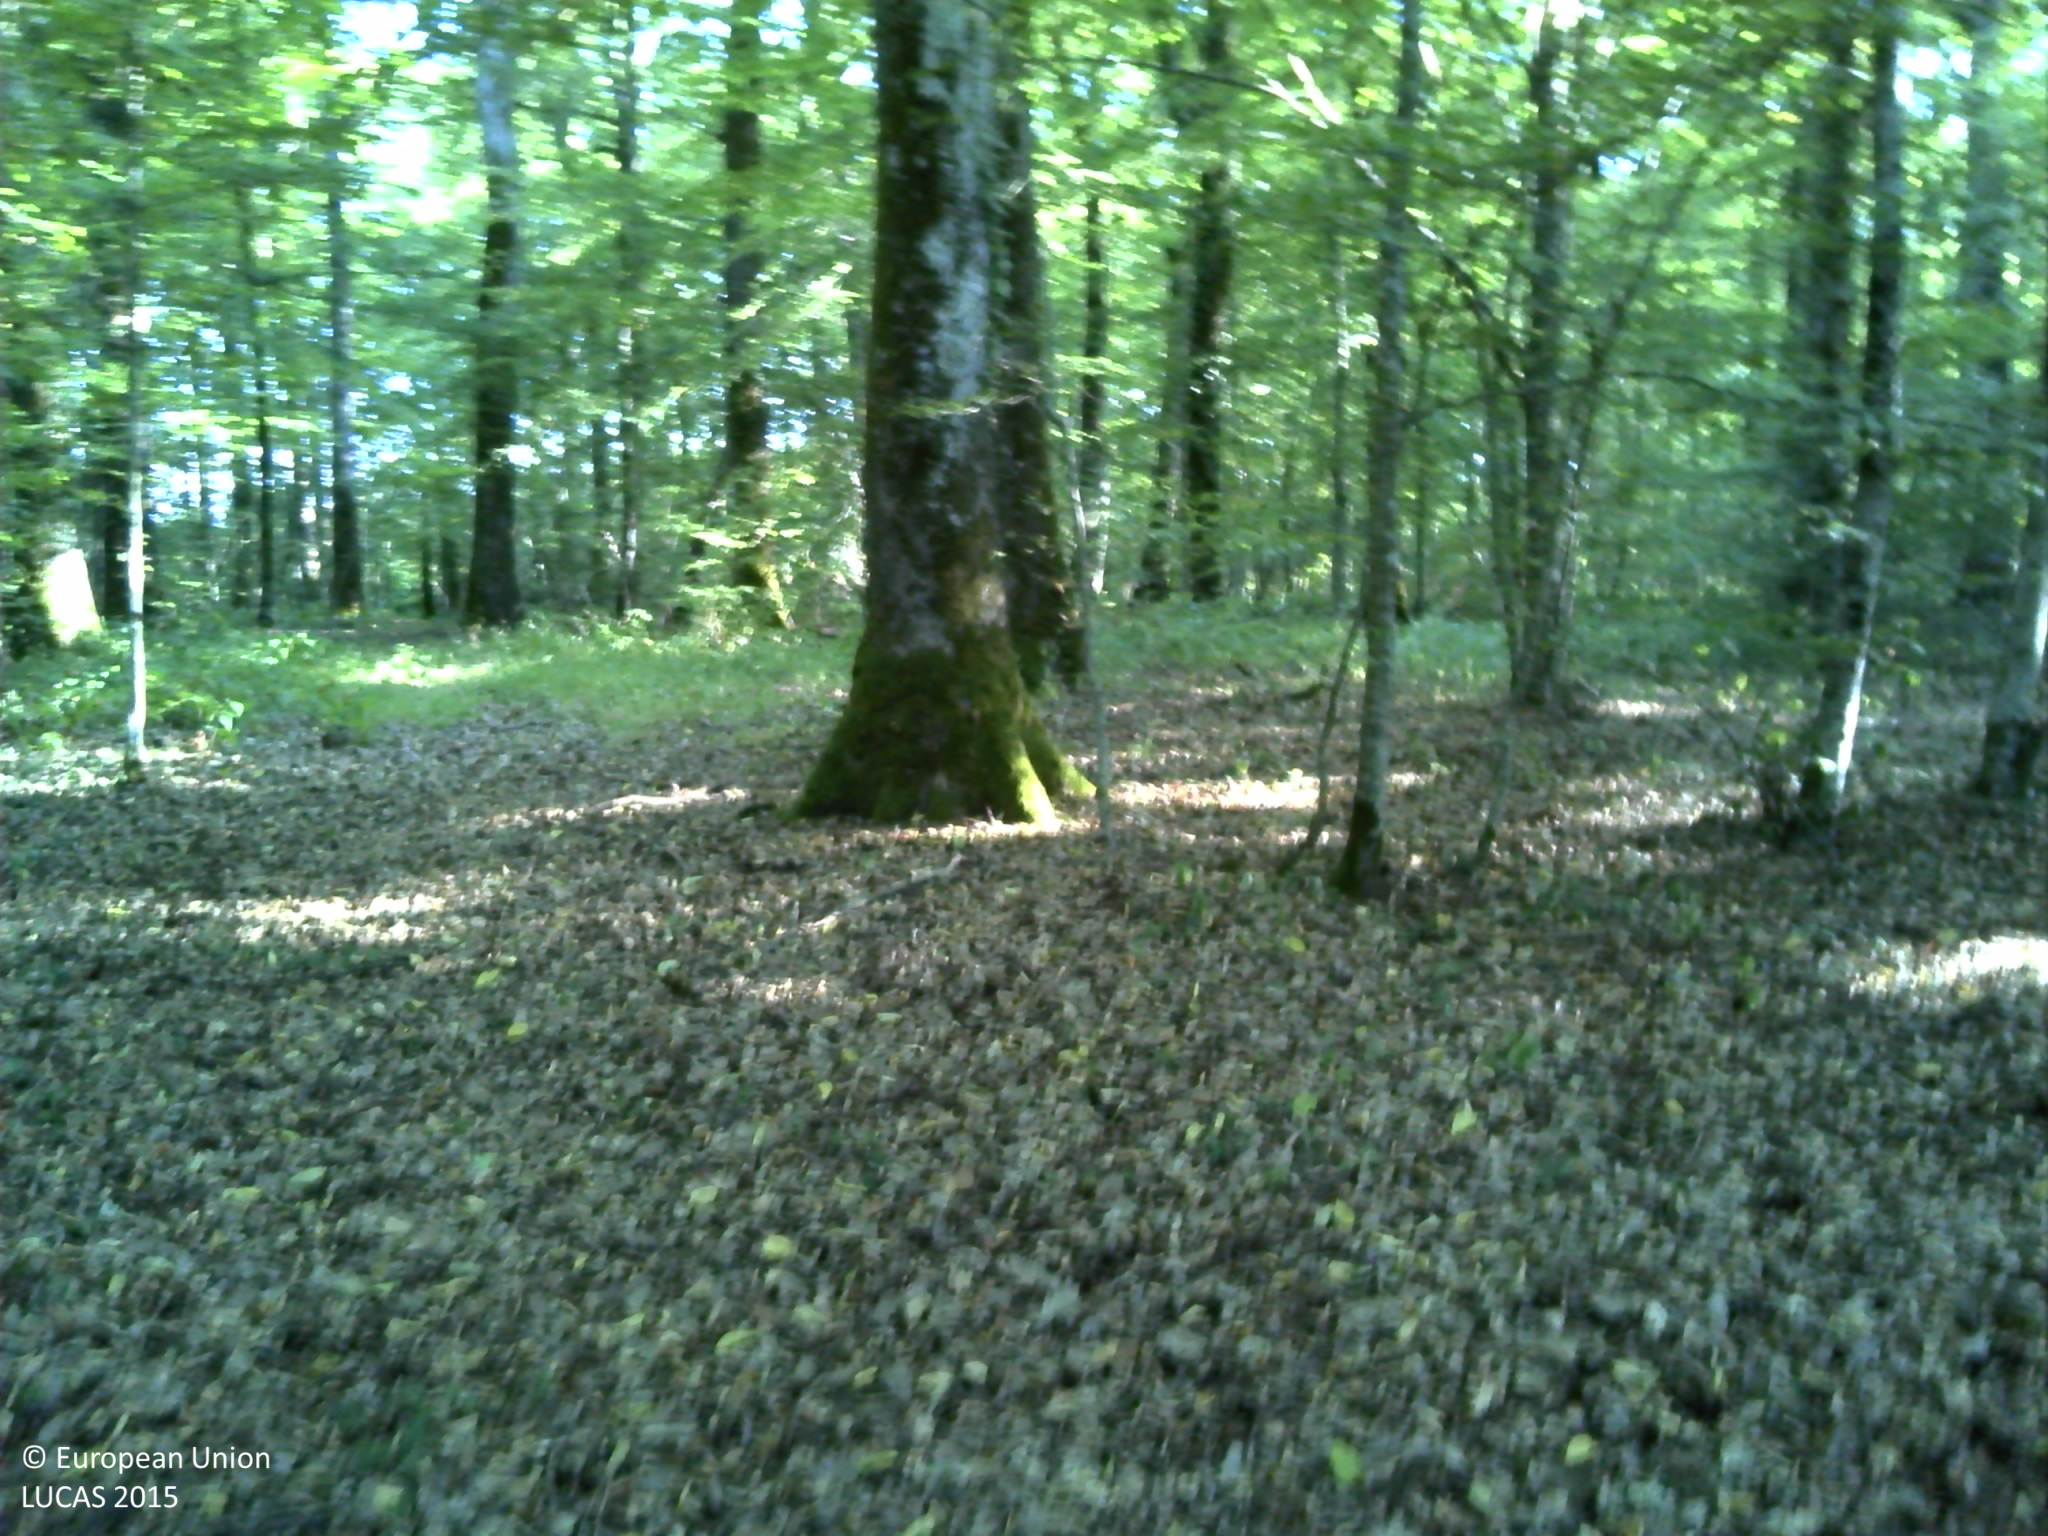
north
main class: Woodland
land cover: Broadleaved woodland
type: mountainous beech forest
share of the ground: > 75 %
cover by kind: broadleaved forest trees 100 %
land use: Forestry
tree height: > 5 m
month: July
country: FR
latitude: 48.2970
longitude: 6.0506
